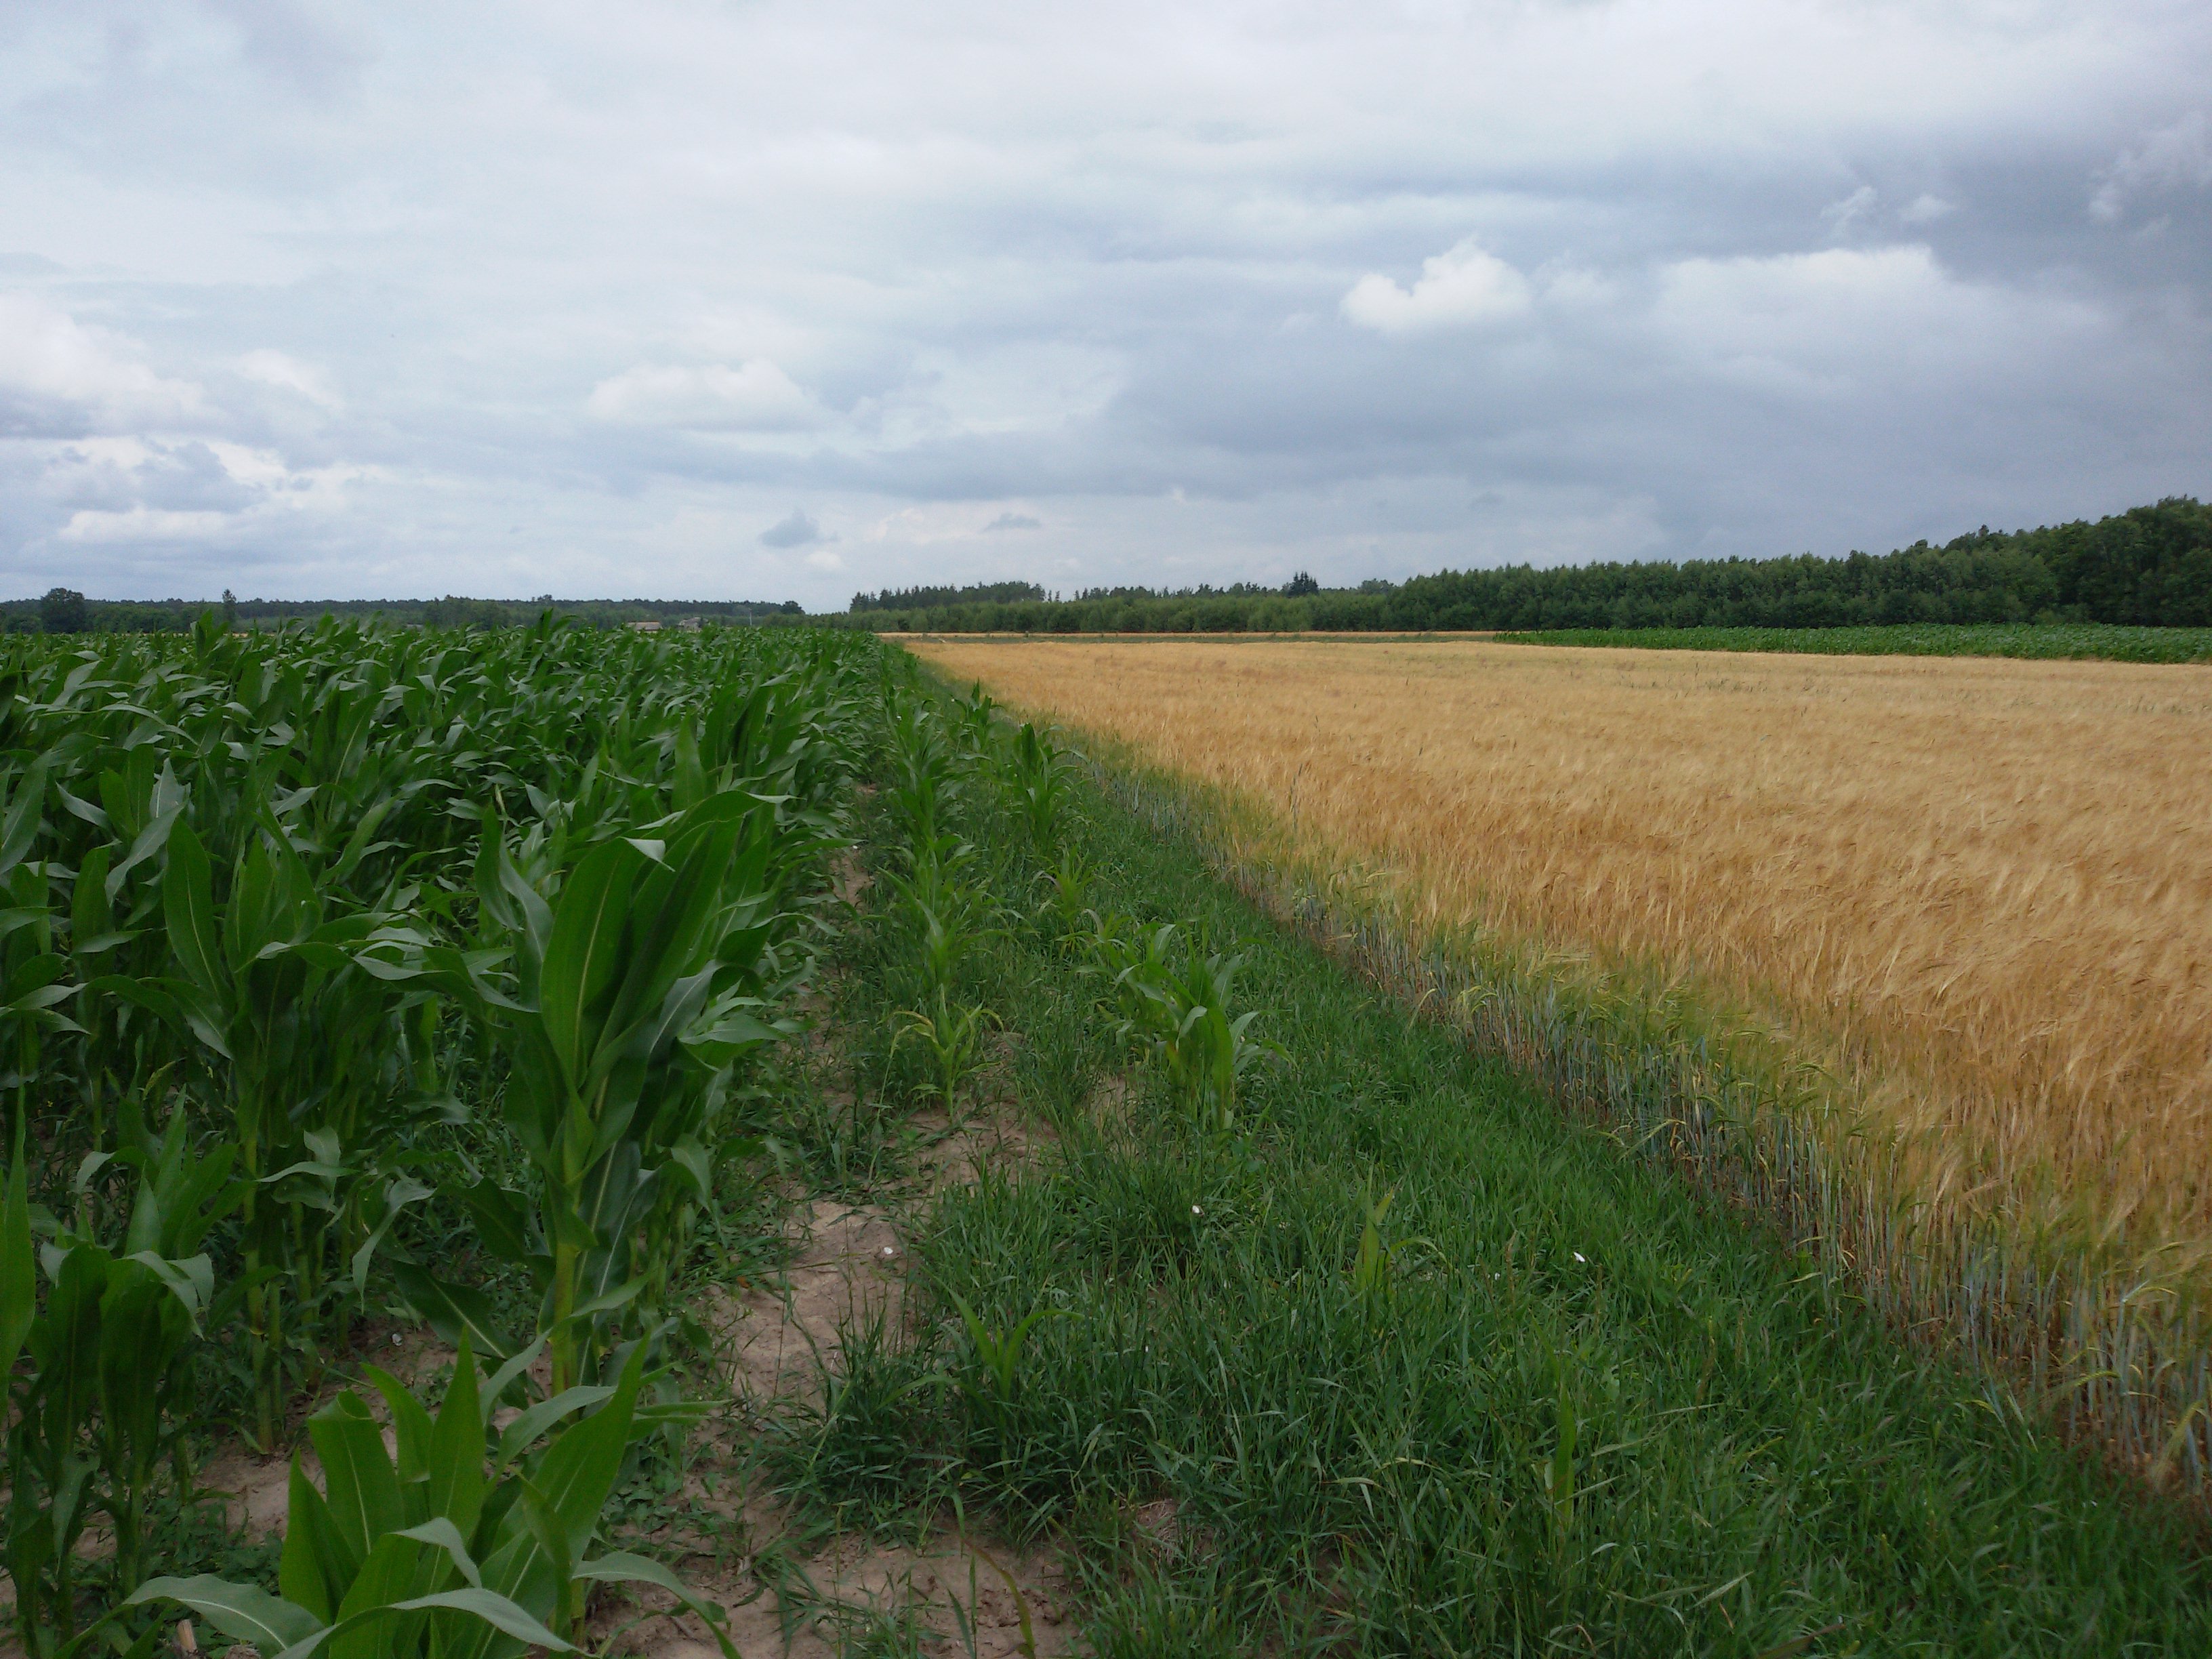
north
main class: Cropland
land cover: Maize
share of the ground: > 75 %
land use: Agriculture (excluding fallow land and kitchen gardens)
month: July
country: PL
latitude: 51.7998
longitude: 22.8774
